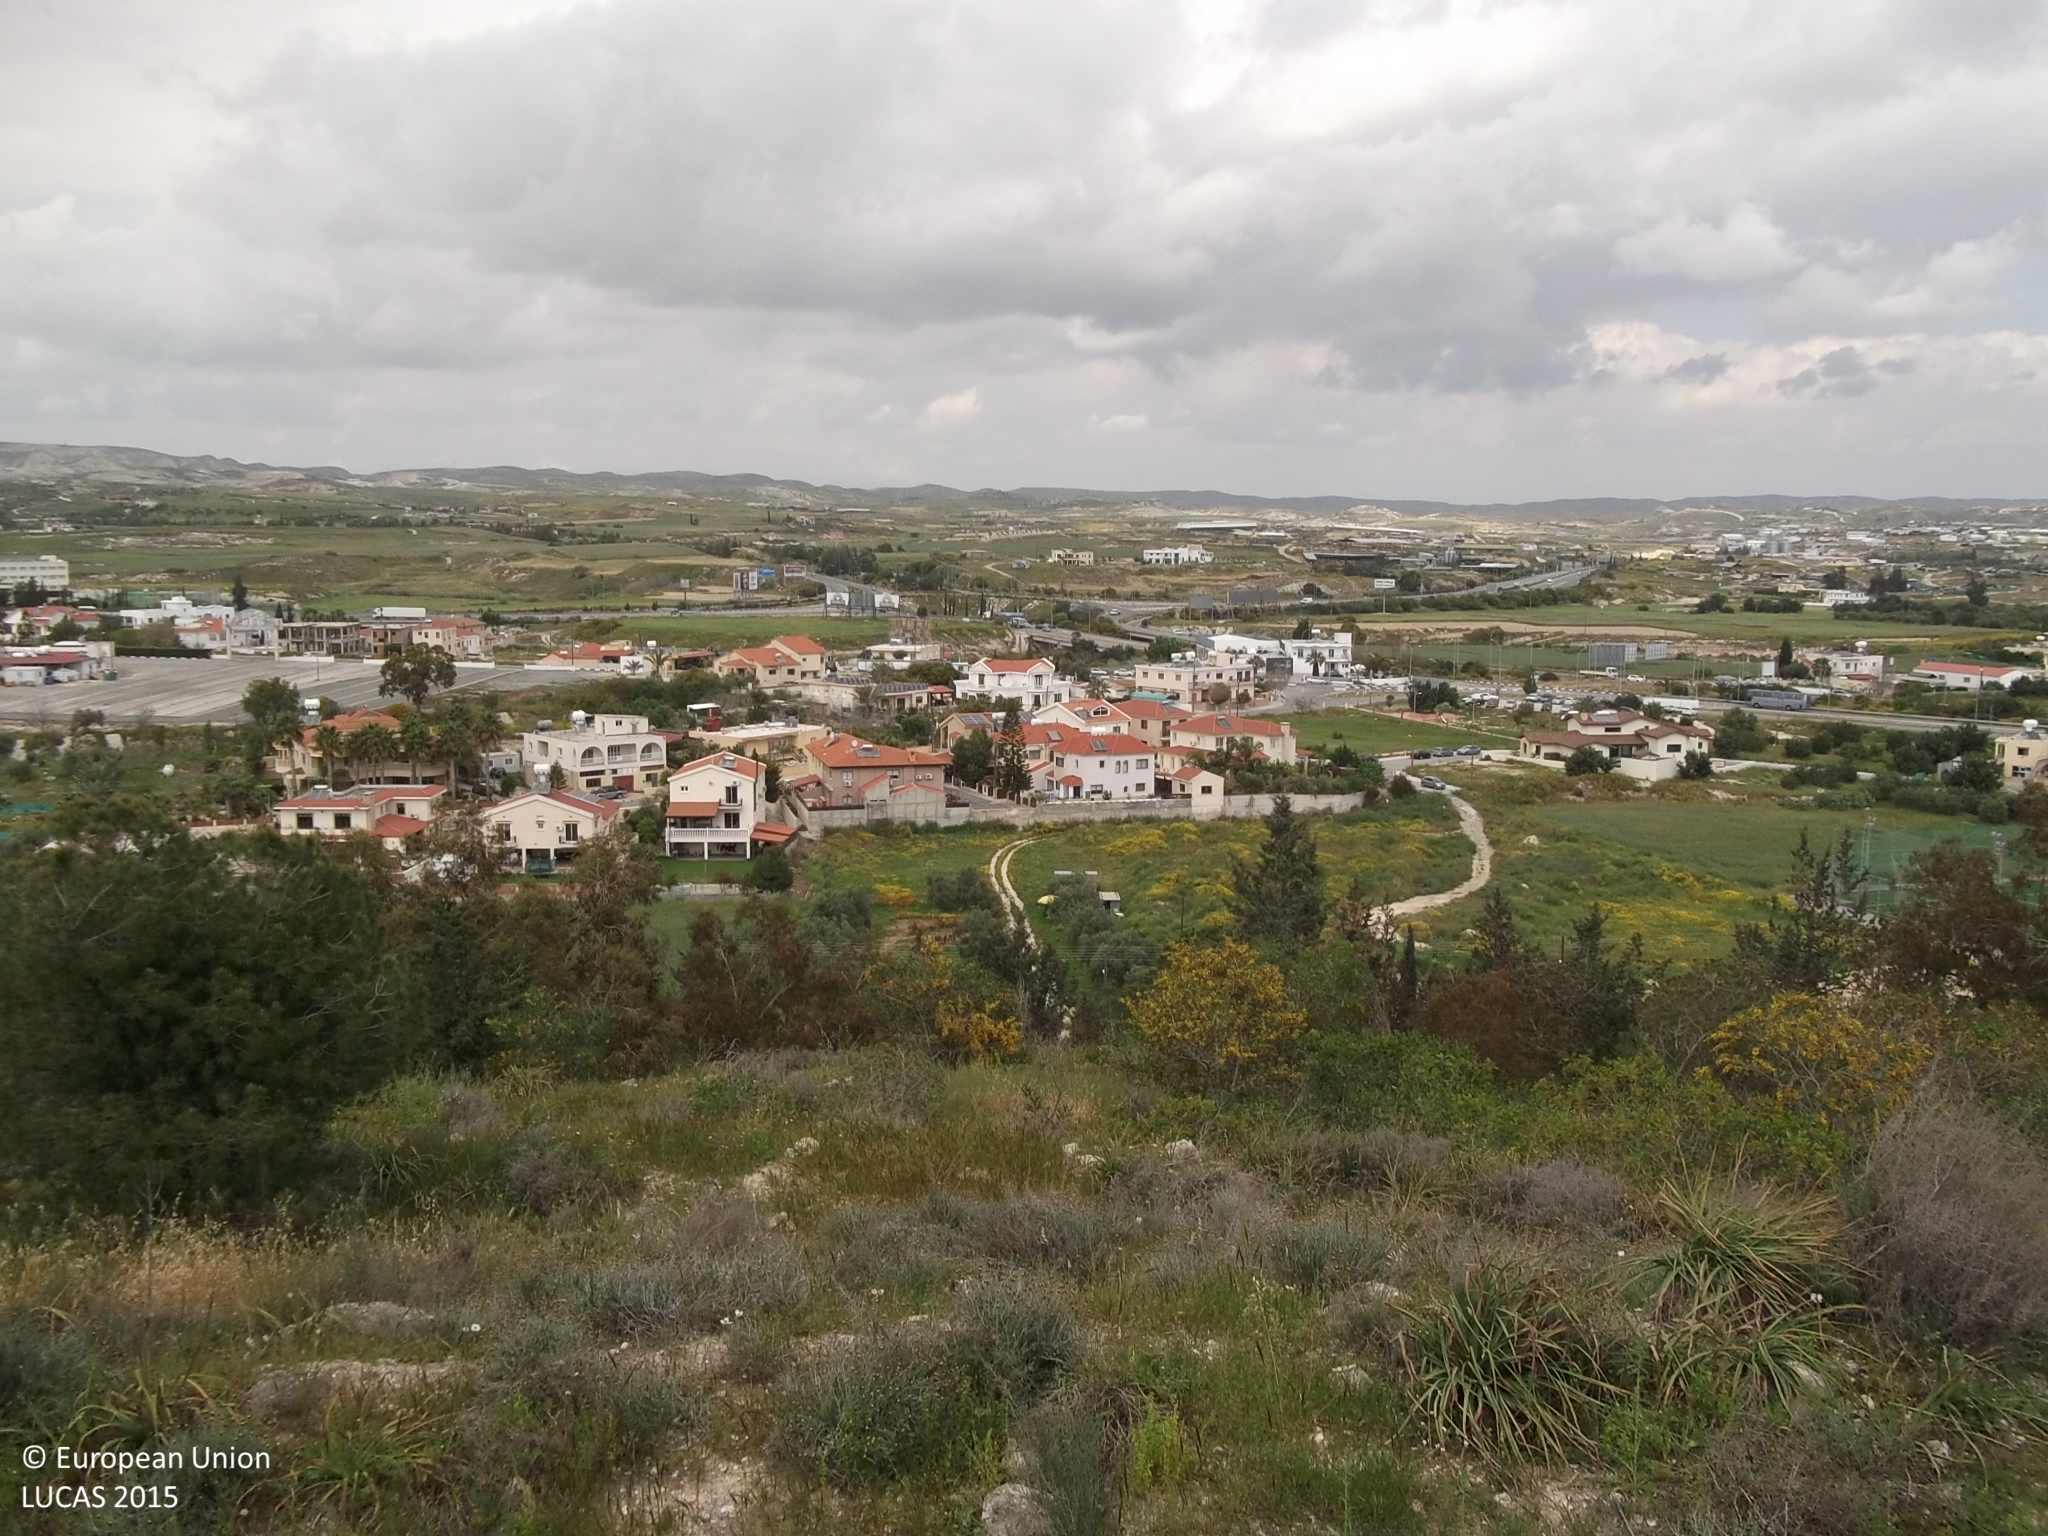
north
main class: Woodland
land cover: Pine dominated coniferous woodland
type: coniferous forest of the mediterranean region
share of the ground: 25 - 50 %
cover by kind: herbaceous plants 50 %, coniferous forest trees 30 %, shrubs 20 %
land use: Semi-natural and natural areas not in use
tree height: > 5 m
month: April
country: CY
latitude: 34.9460
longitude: 33.5724
